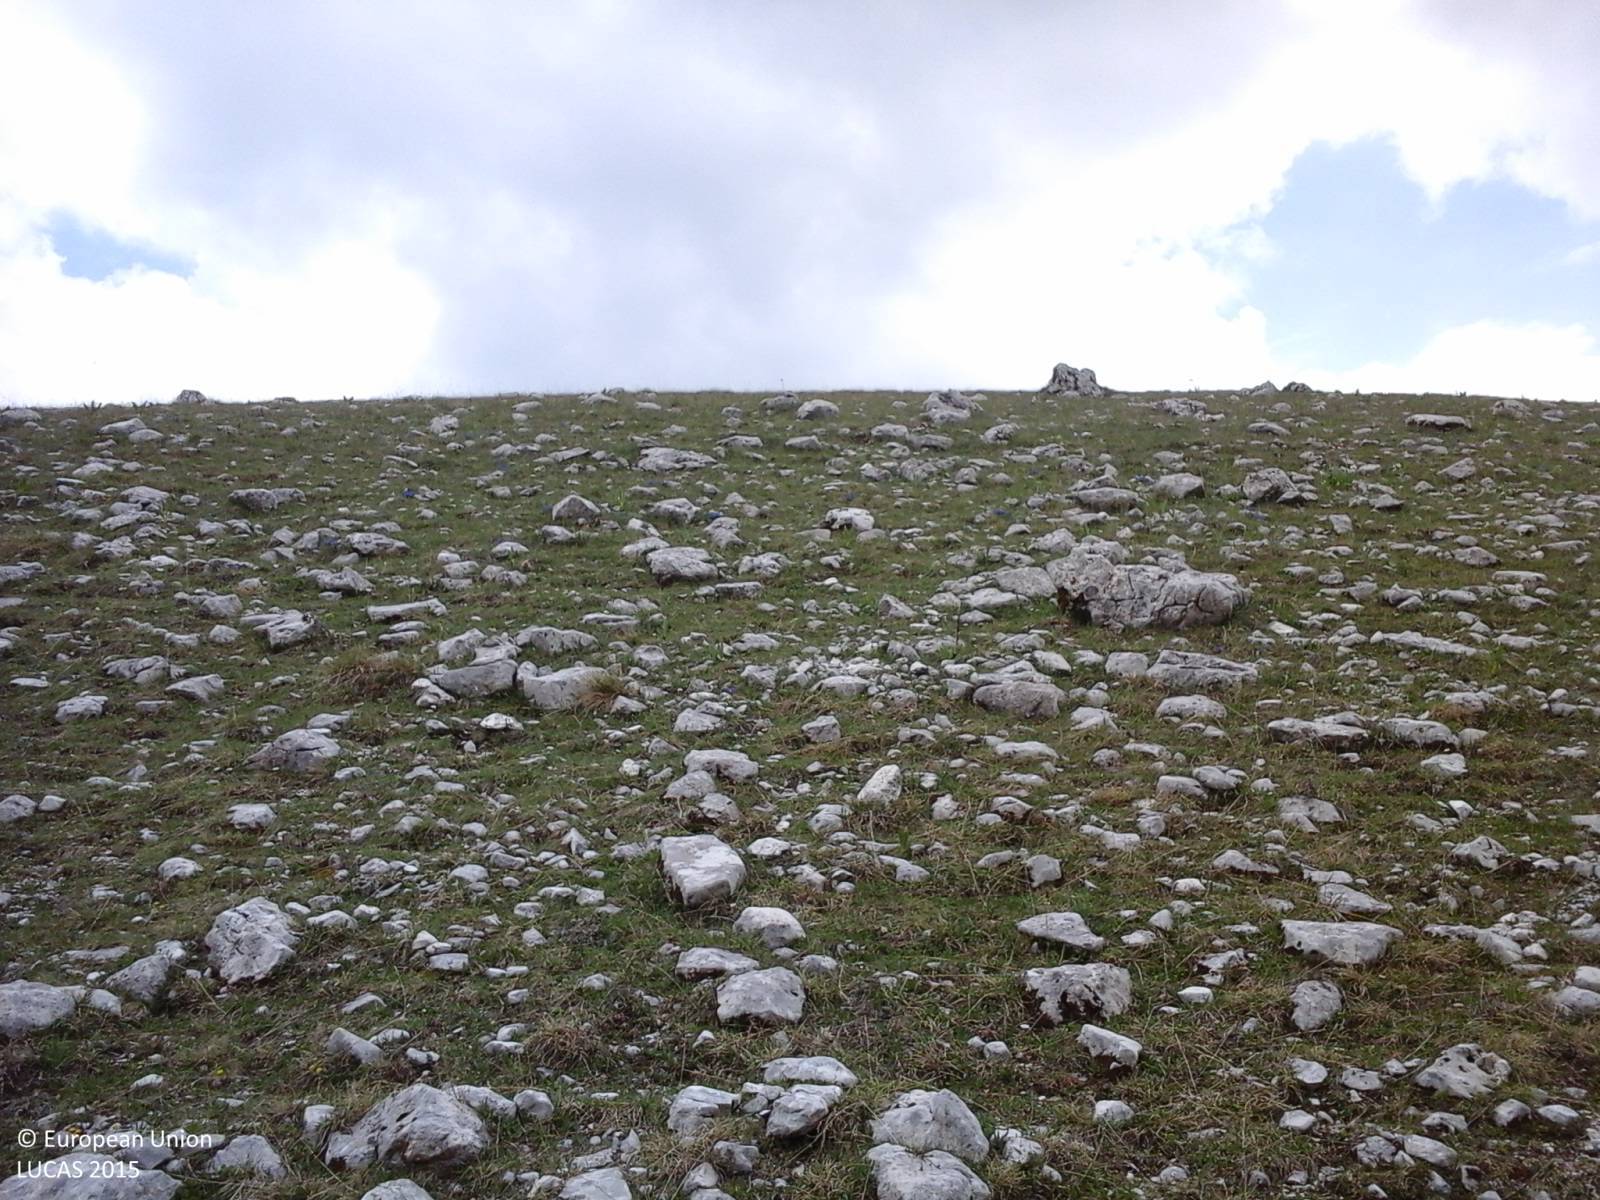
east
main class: Grassland
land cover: Grassland without tree/shrub cover
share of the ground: > 75 %
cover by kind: herbaceous plants 85 %, unconsolidated bare surface 10 %
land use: Agriculture (excluding fallow land and kitchen gardens)
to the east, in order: Grassland without tree/shrub cover
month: June
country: IT
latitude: 41.8165
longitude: 13.9708
